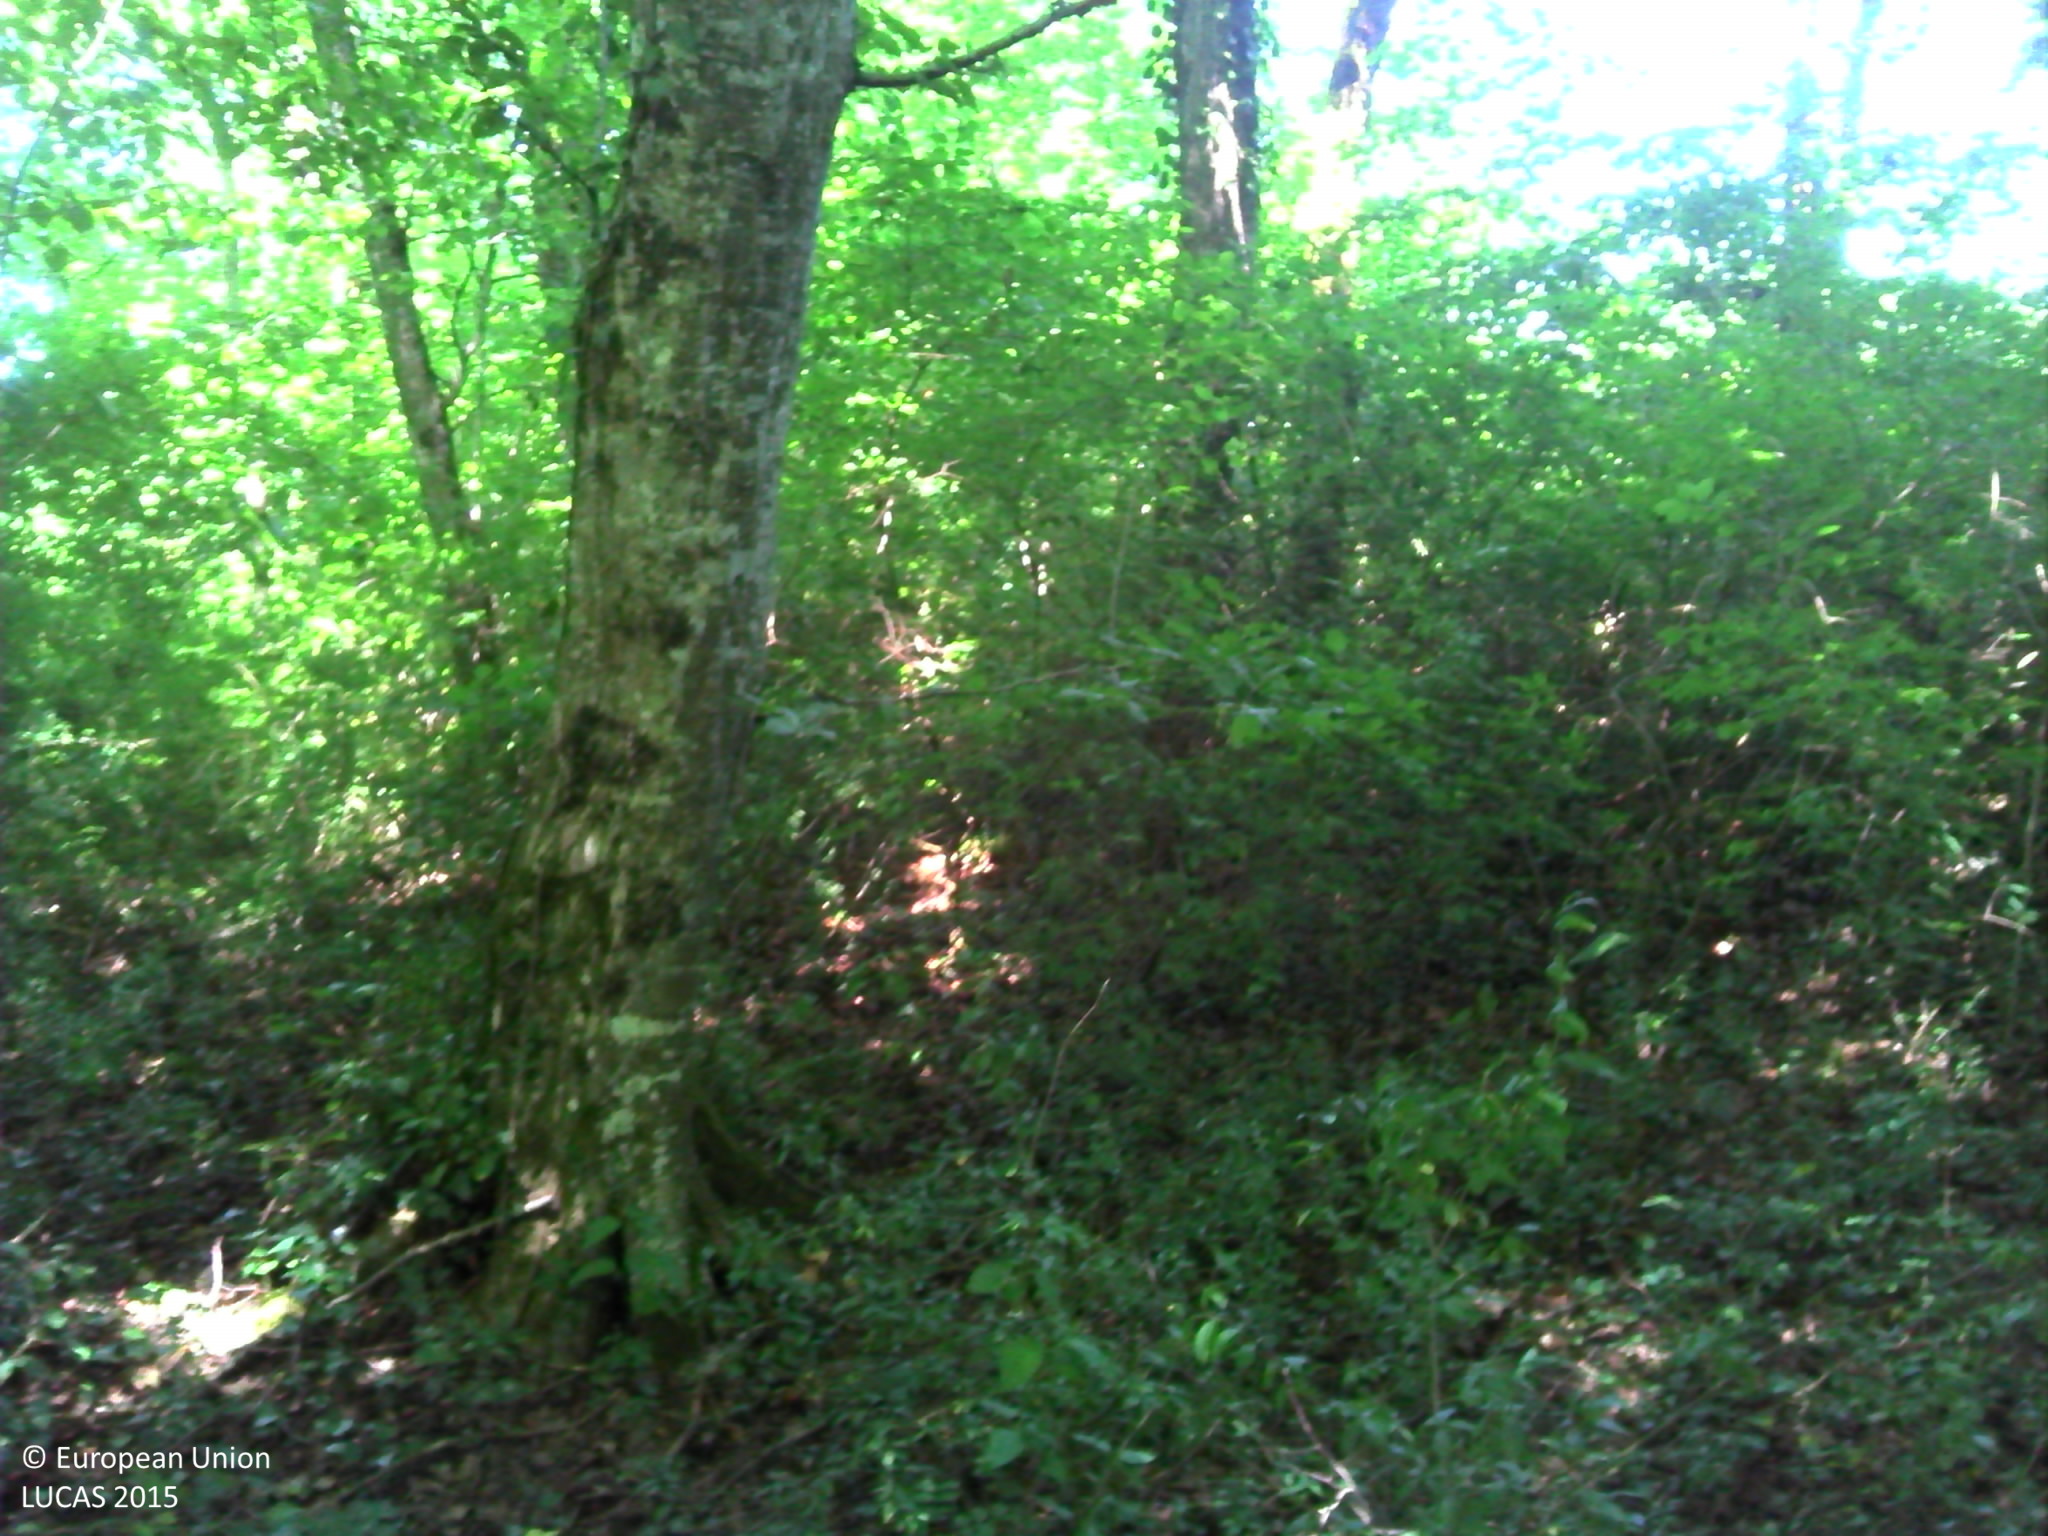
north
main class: Woodland
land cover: Broadleaved woodland
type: beech forest
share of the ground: > 75 %
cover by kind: broadleaved forest trees 90 %, herbaceous plants 10 %
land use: Forestry
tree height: > 5 m
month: June
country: FR
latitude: 47.4571
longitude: 6.2477
